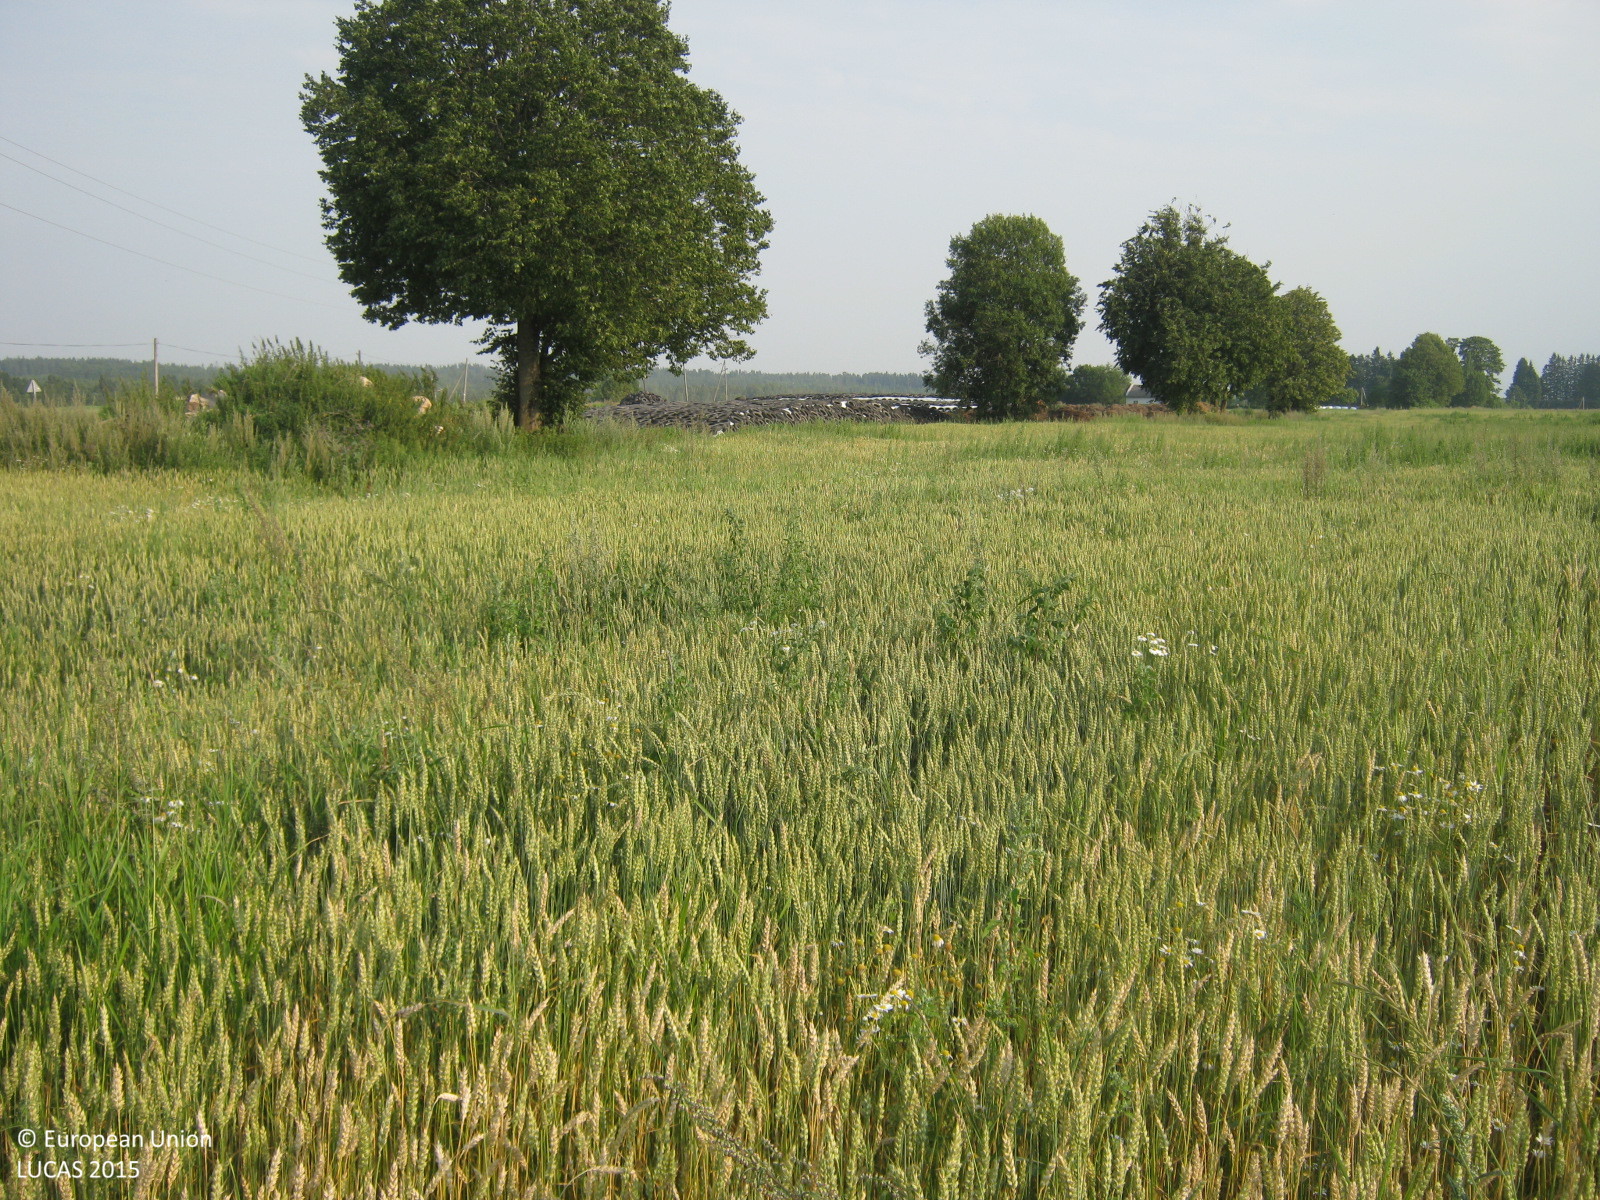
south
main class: Cropland
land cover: Common wheat
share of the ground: > 75 %
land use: Agriculture (excluding fallow land and kitchen gardens)
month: August
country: LV
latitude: 57.4267
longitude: 24.6673
